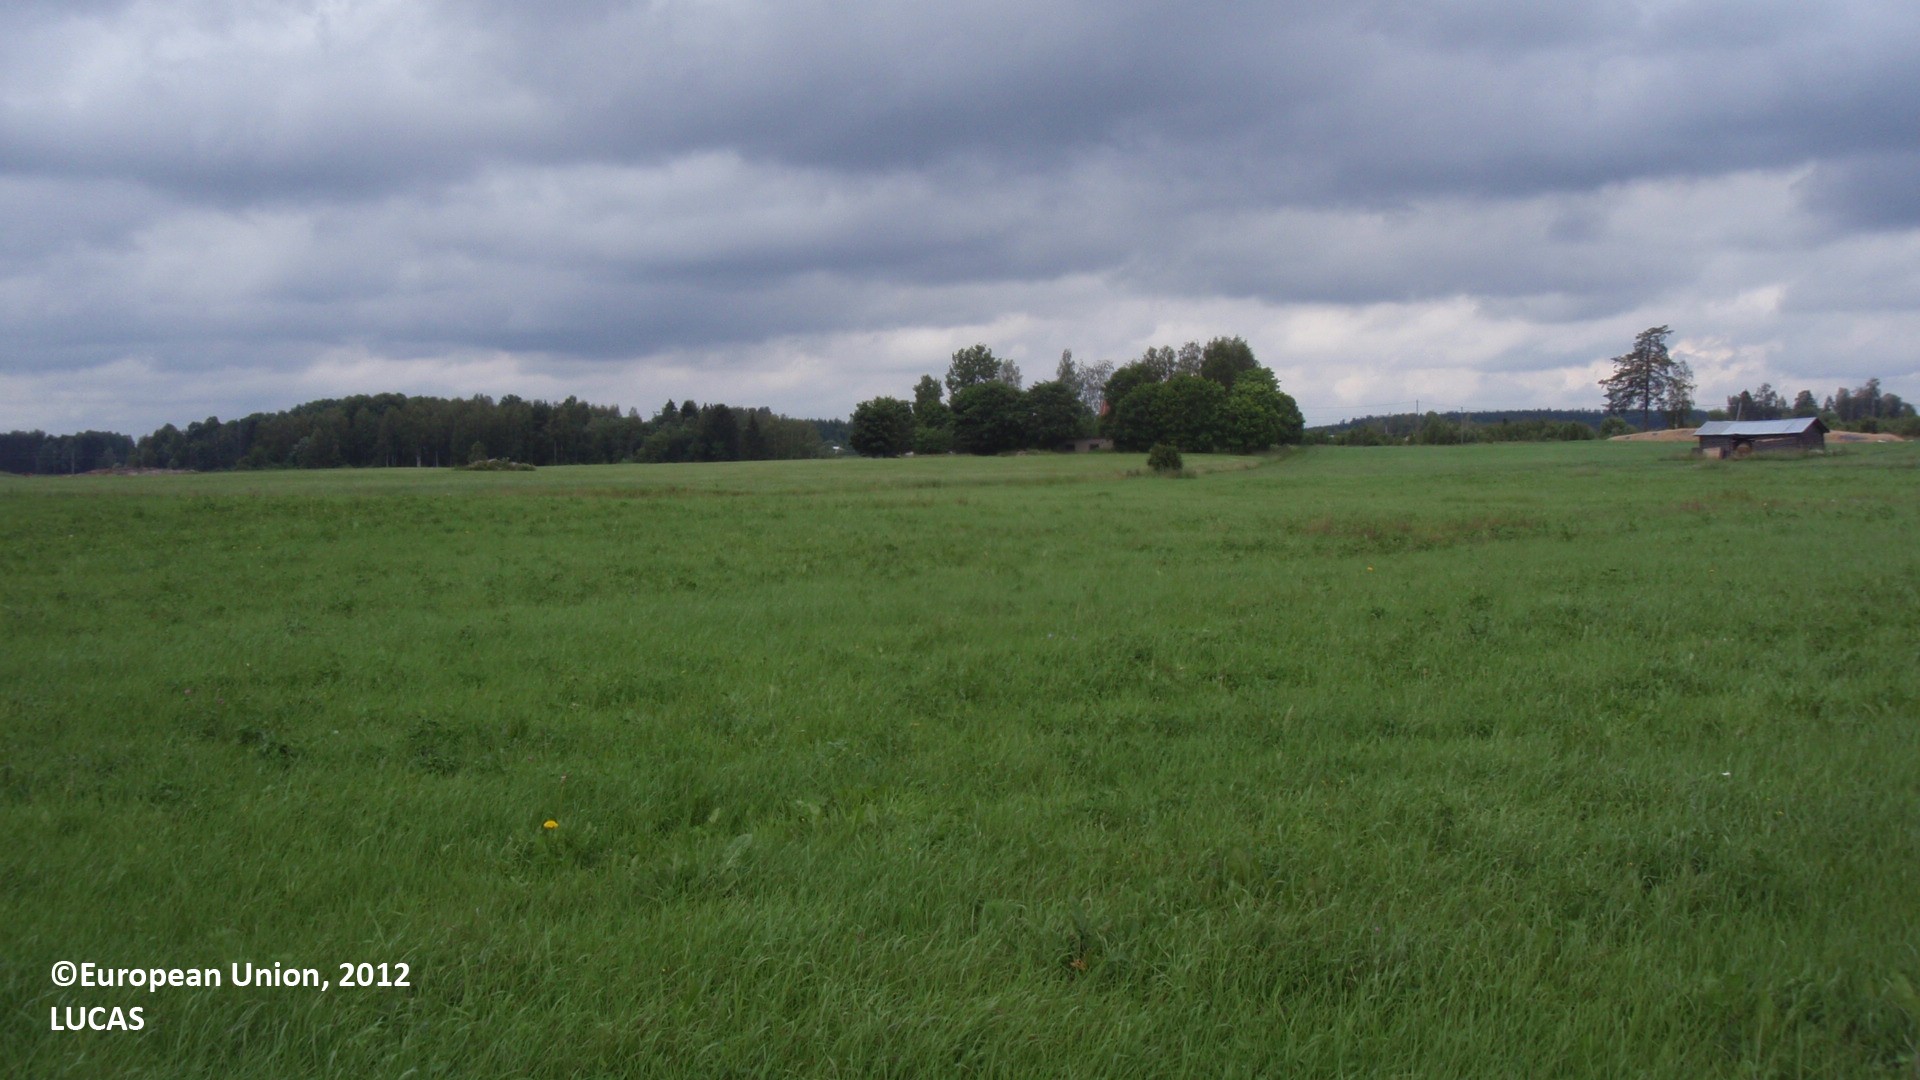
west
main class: Cropland
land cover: Temporary grasslands
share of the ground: > 75 %
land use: Agriculture (excluding fallow land and kitchen gardens)
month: July
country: FI
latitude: 61.0578
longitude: 28.4999
